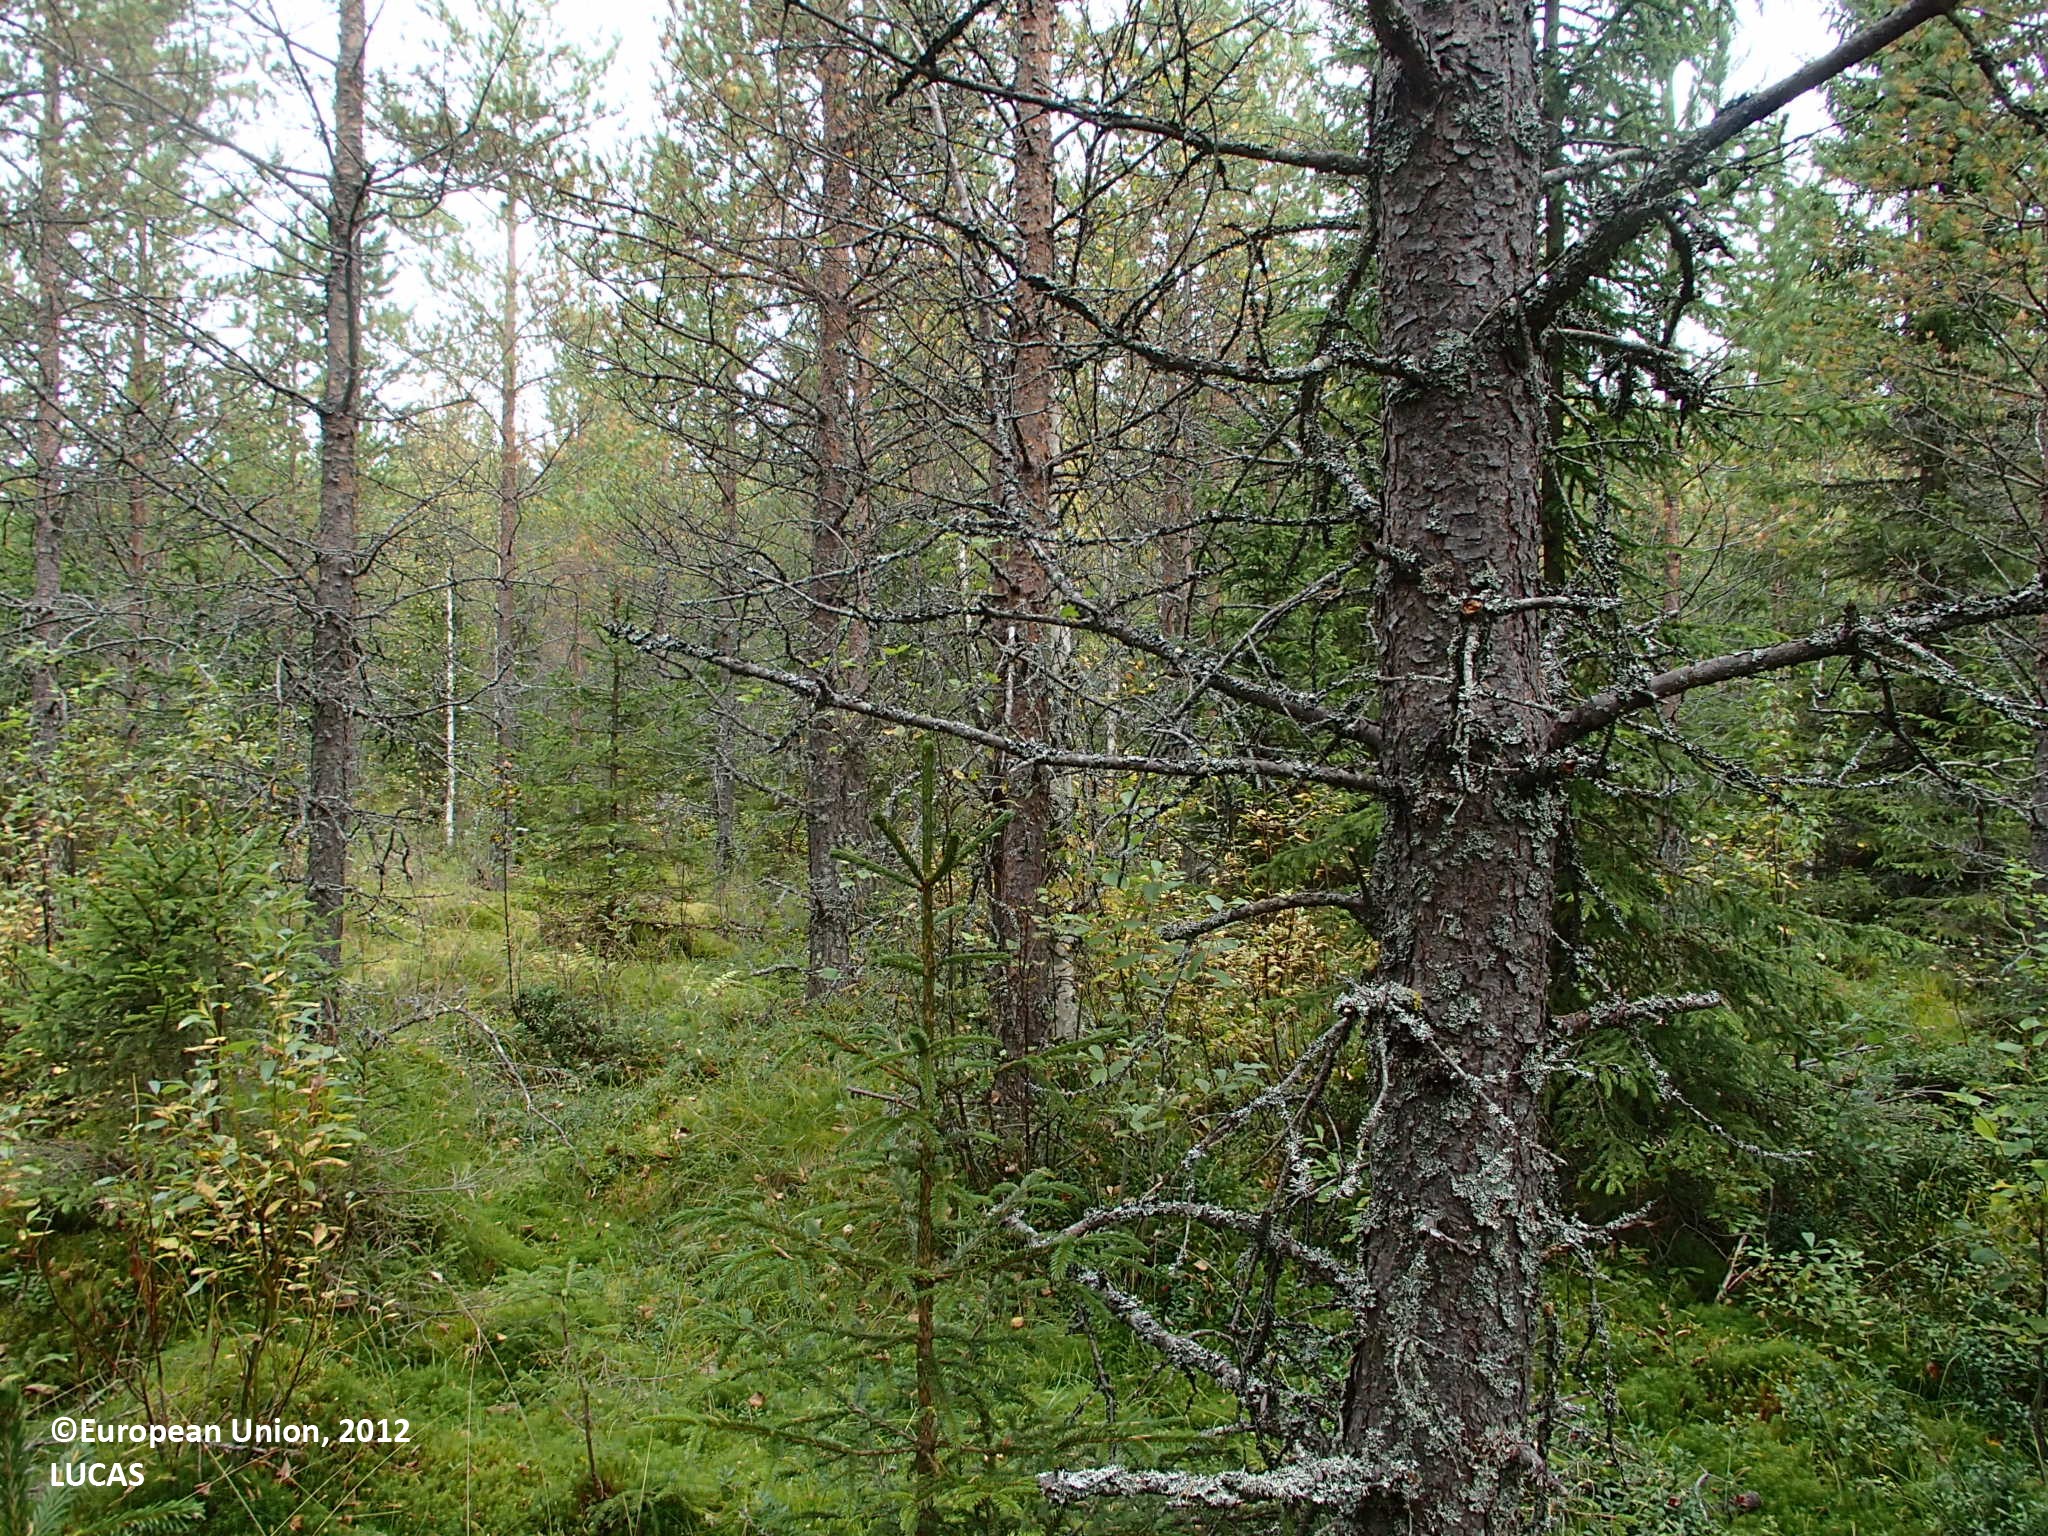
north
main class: Woodland
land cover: Other coniferous woodland
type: boreal forest
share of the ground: > 75 %
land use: Forestry
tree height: > 5 m
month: September
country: FI
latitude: 63.8523
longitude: 26.0355
